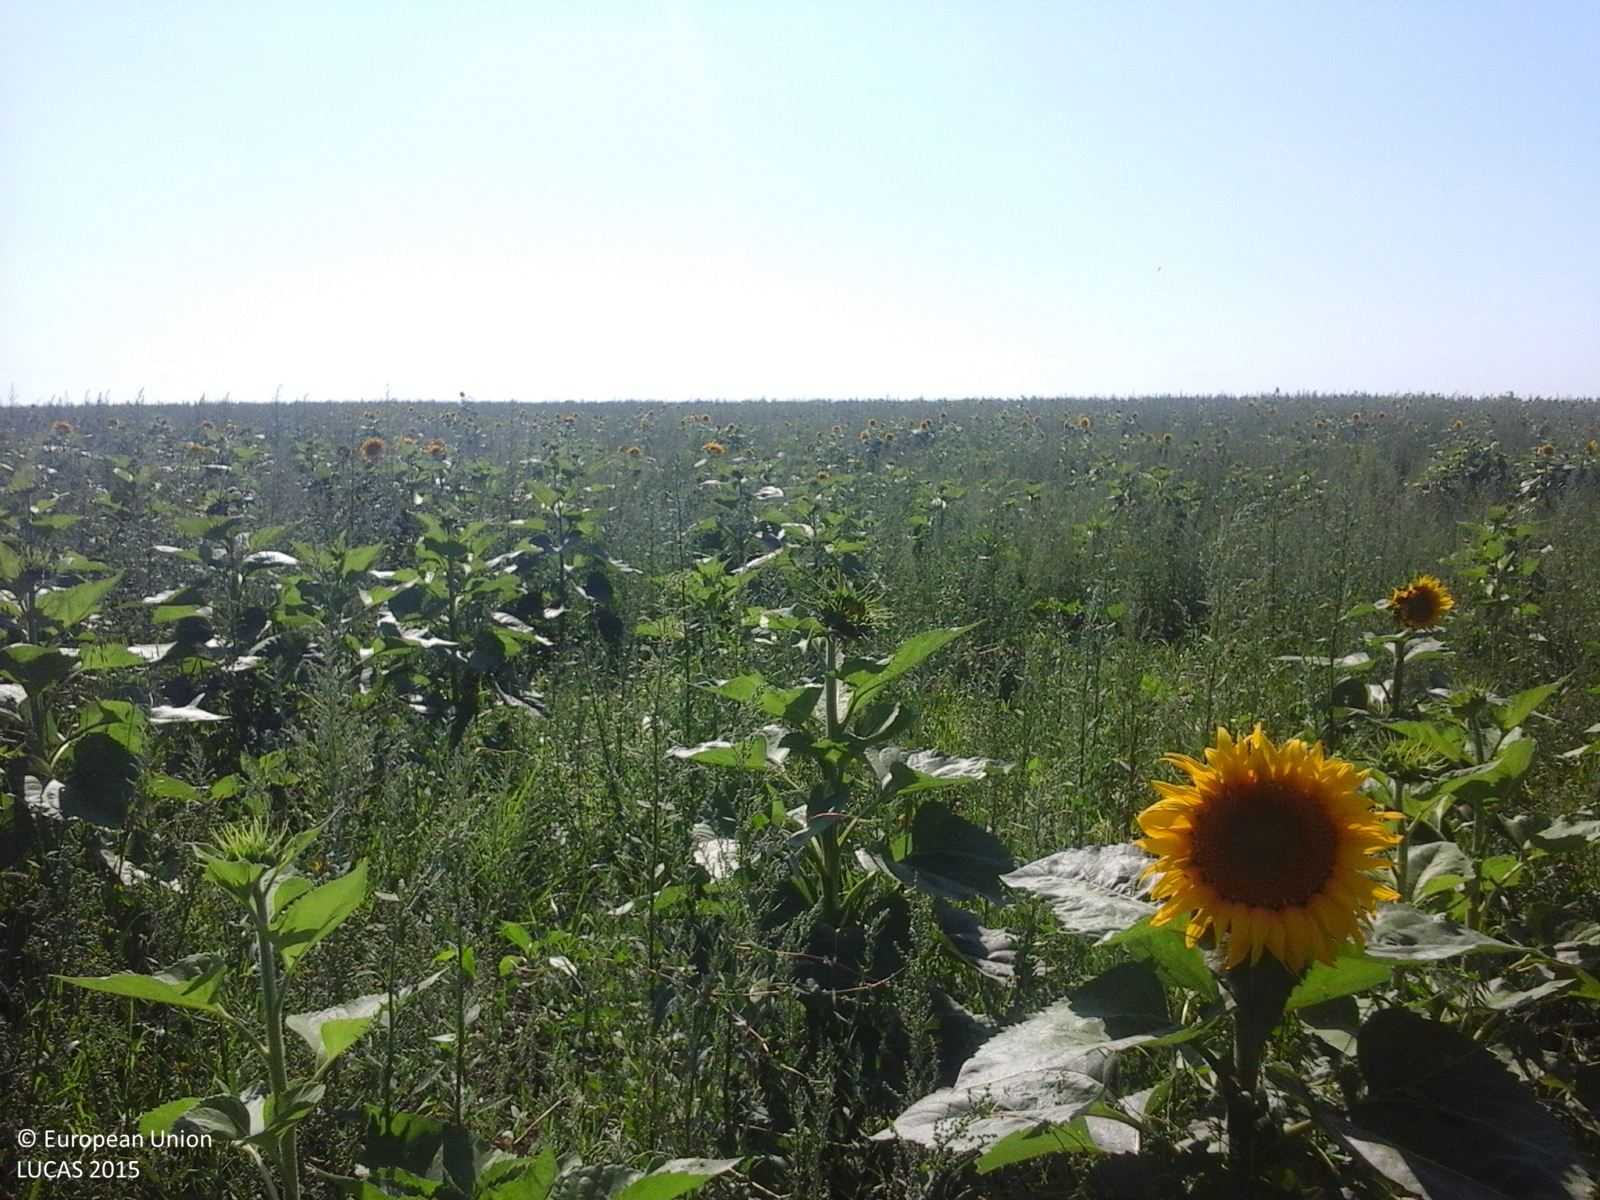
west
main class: Grassland
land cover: Spontaneously vegetated surfaces
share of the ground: > 75 %
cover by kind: herbaceous plants 100 %
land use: Fallow land
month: July
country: RO
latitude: 44.2542
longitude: 24.6630
